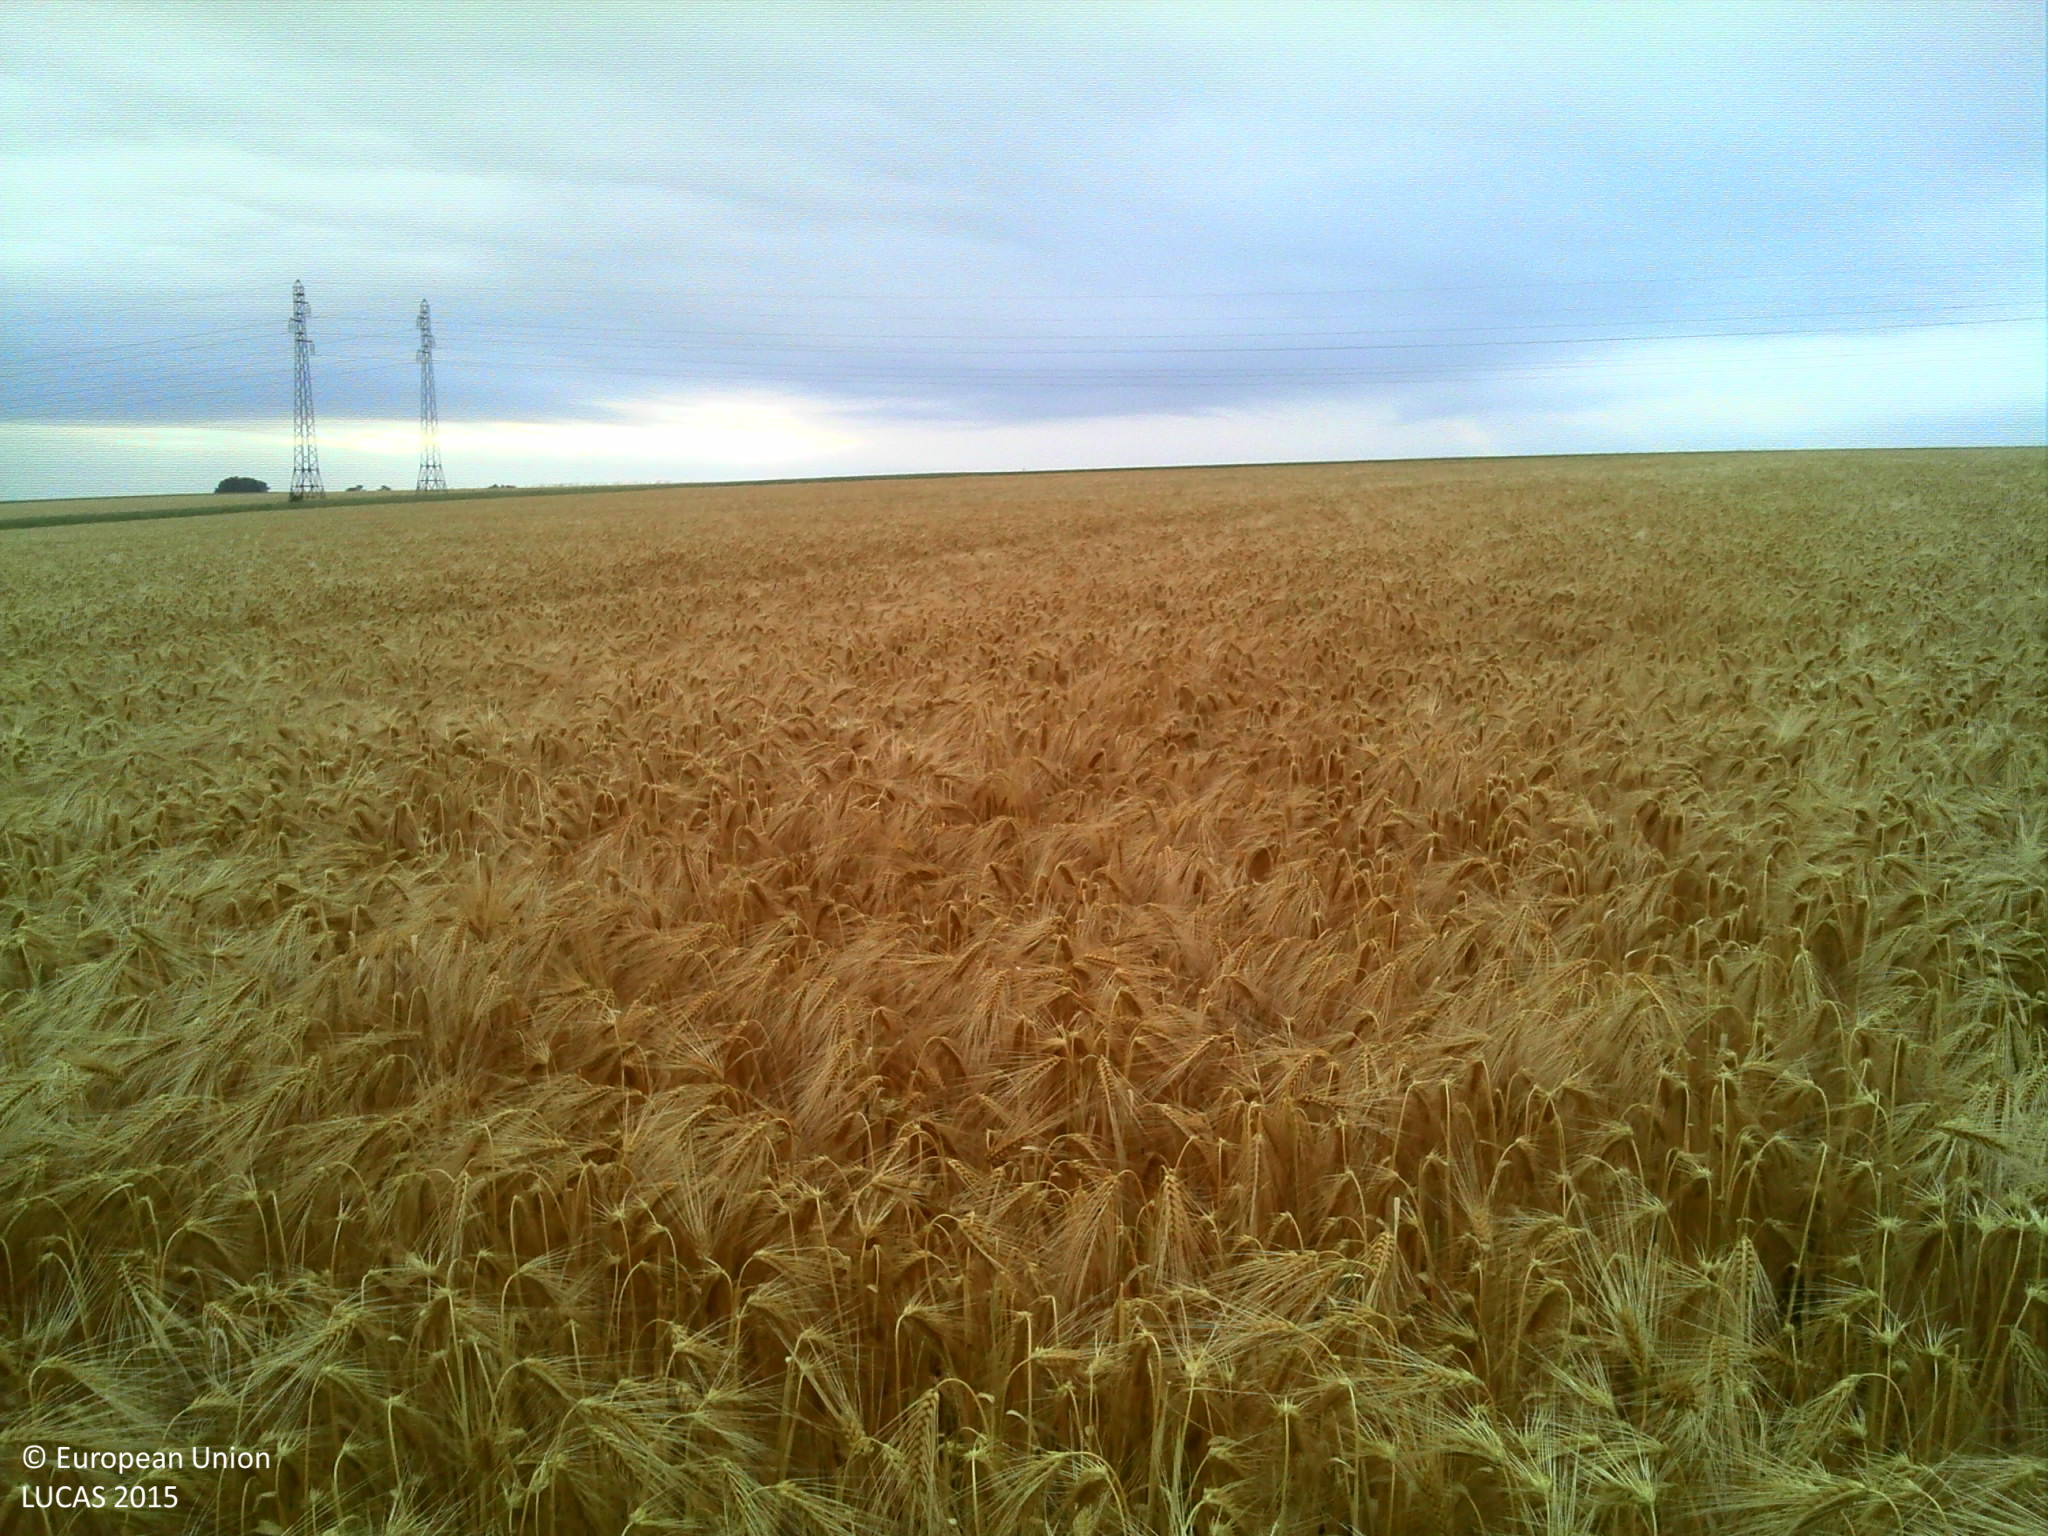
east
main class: Cropland
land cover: Barley
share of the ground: > 75 %
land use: Agriculture (excluding fallow land and kitchen gardens)
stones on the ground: 10 - 25 %
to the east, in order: Barley; Ditches and canals; Grass margins; Paved roads, cycling and walking lanes; Grass margins; Ditches and canals; Grass margins; Common wheat; Electric lines; Common wheat; Electric lines; Common wheat
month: June
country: FR
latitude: 47.8749
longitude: 3.9132
